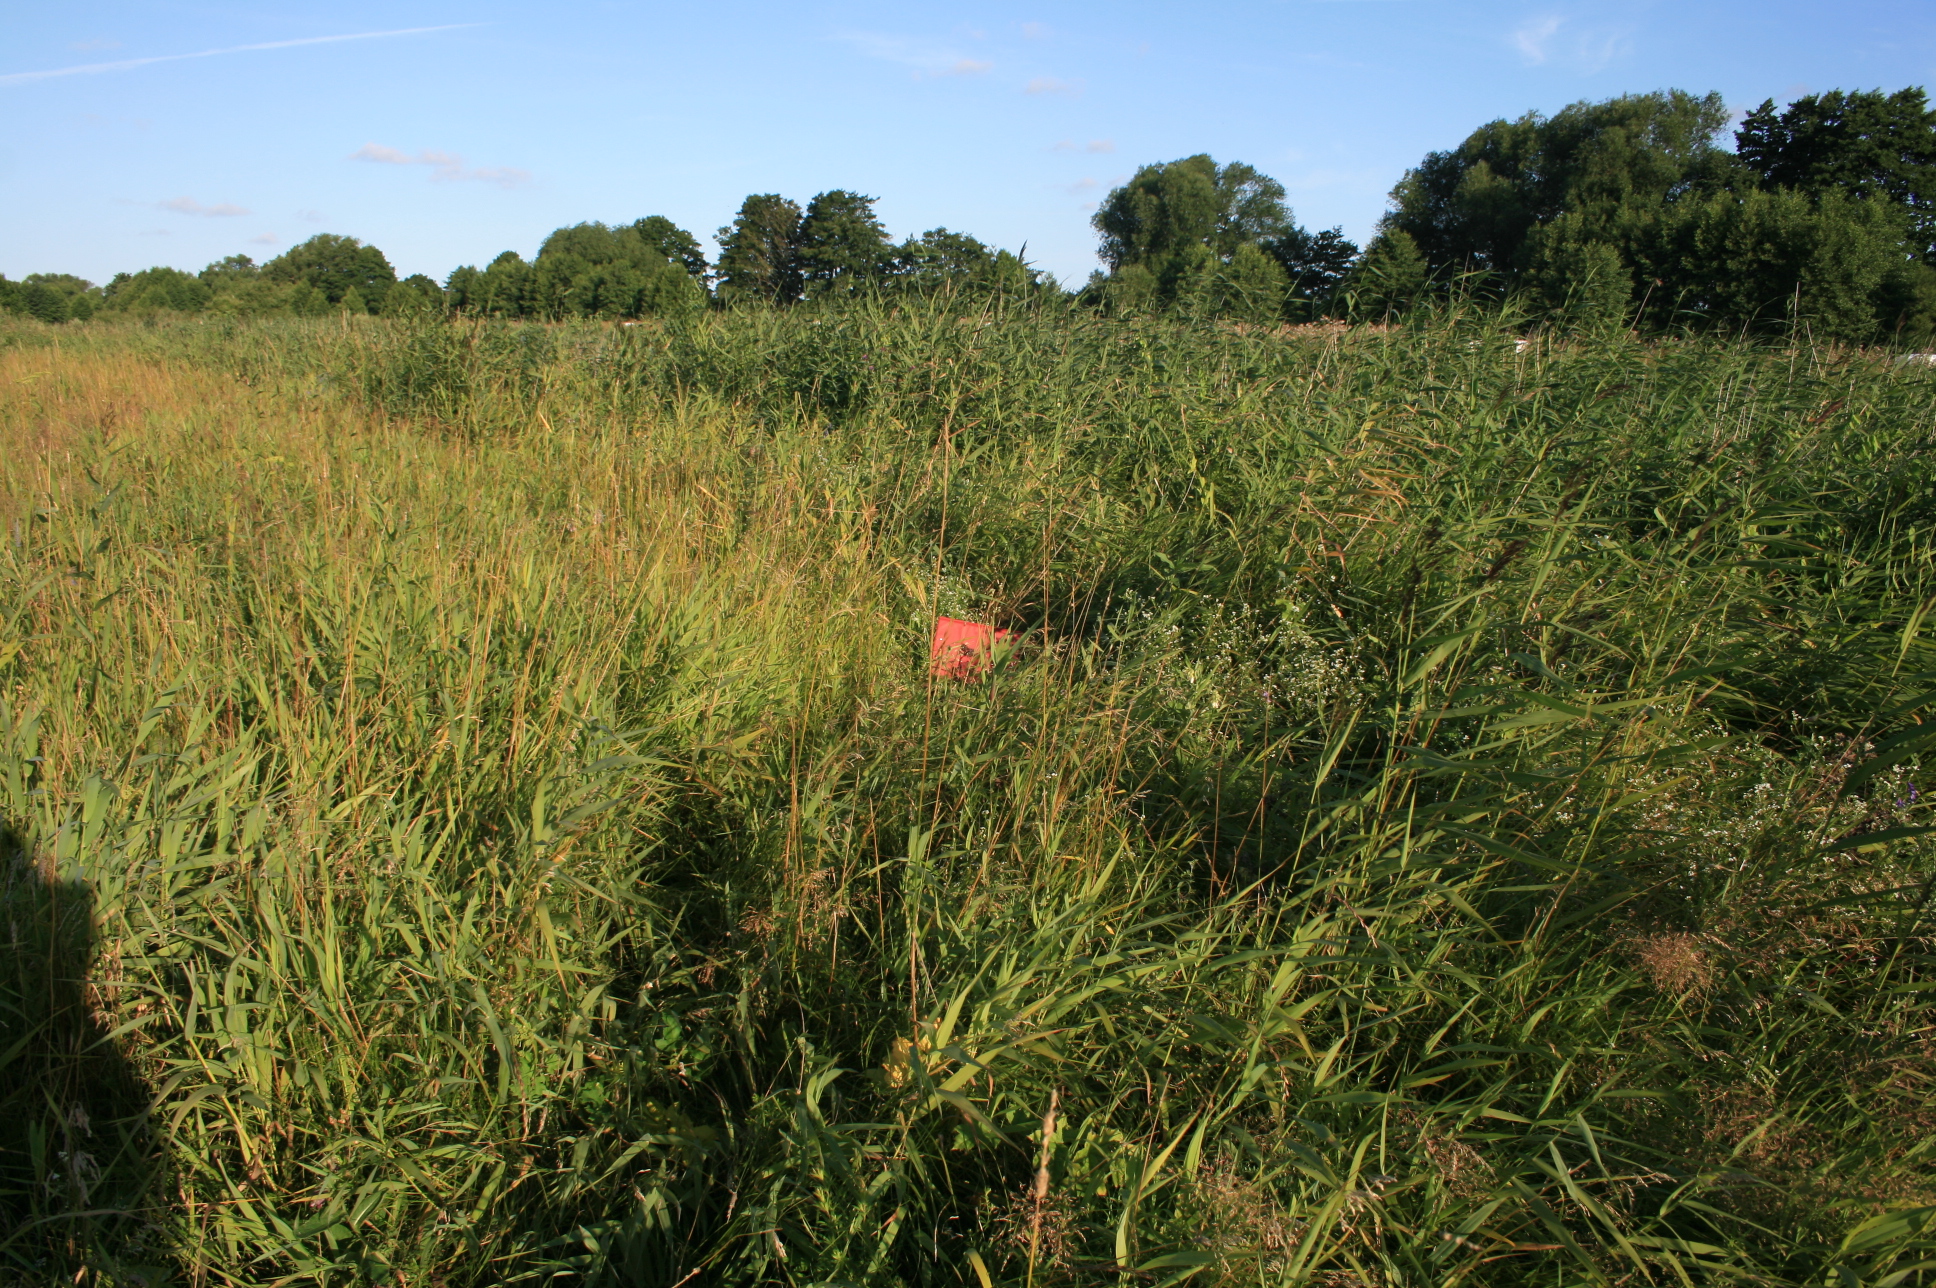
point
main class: Grassland
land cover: Spontaneously vegetated surfaces
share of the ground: > 75 %
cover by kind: herbaceous plants 100 %
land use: Semi-natural and natural areas not in use
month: July
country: LT
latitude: 55.3428
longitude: 21.2859
